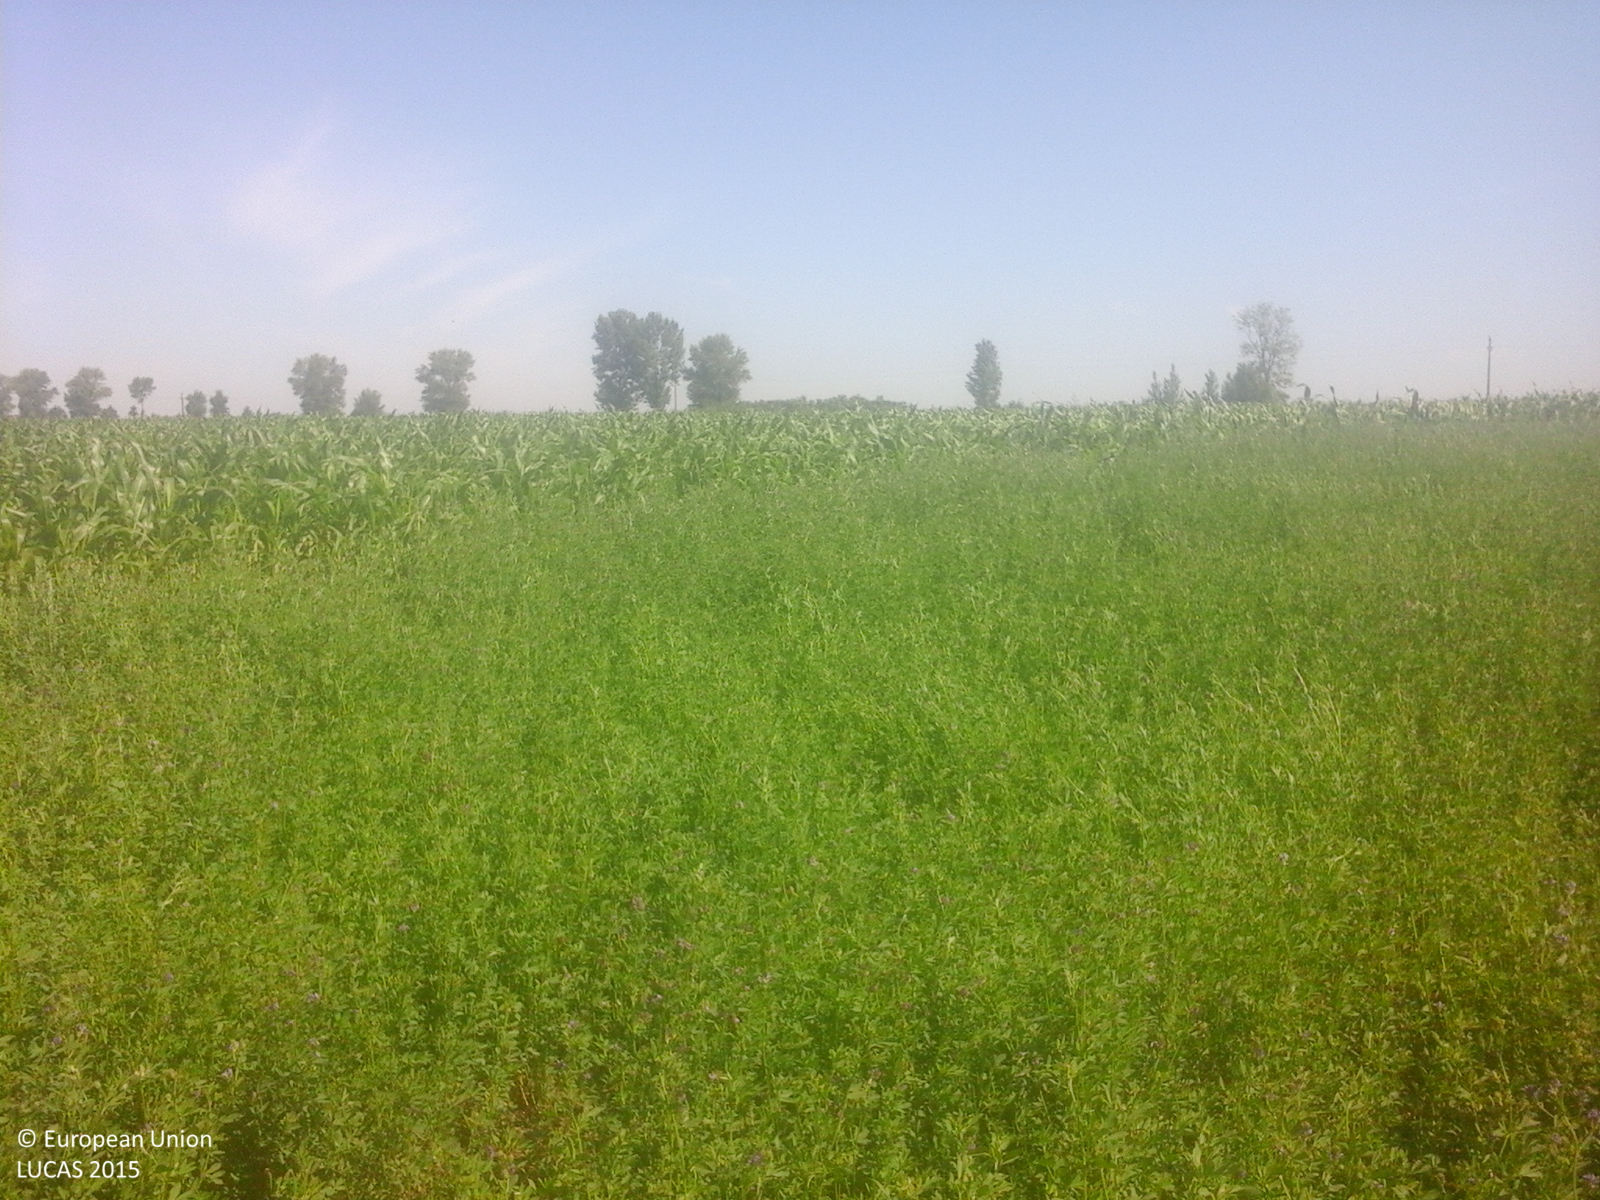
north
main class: Cropland
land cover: Lucerne
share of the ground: > 75 %
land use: Agriculture (excluding fallow land and kitchen gardens)
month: June
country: RO
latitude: 47.8282
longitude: 27.1140
